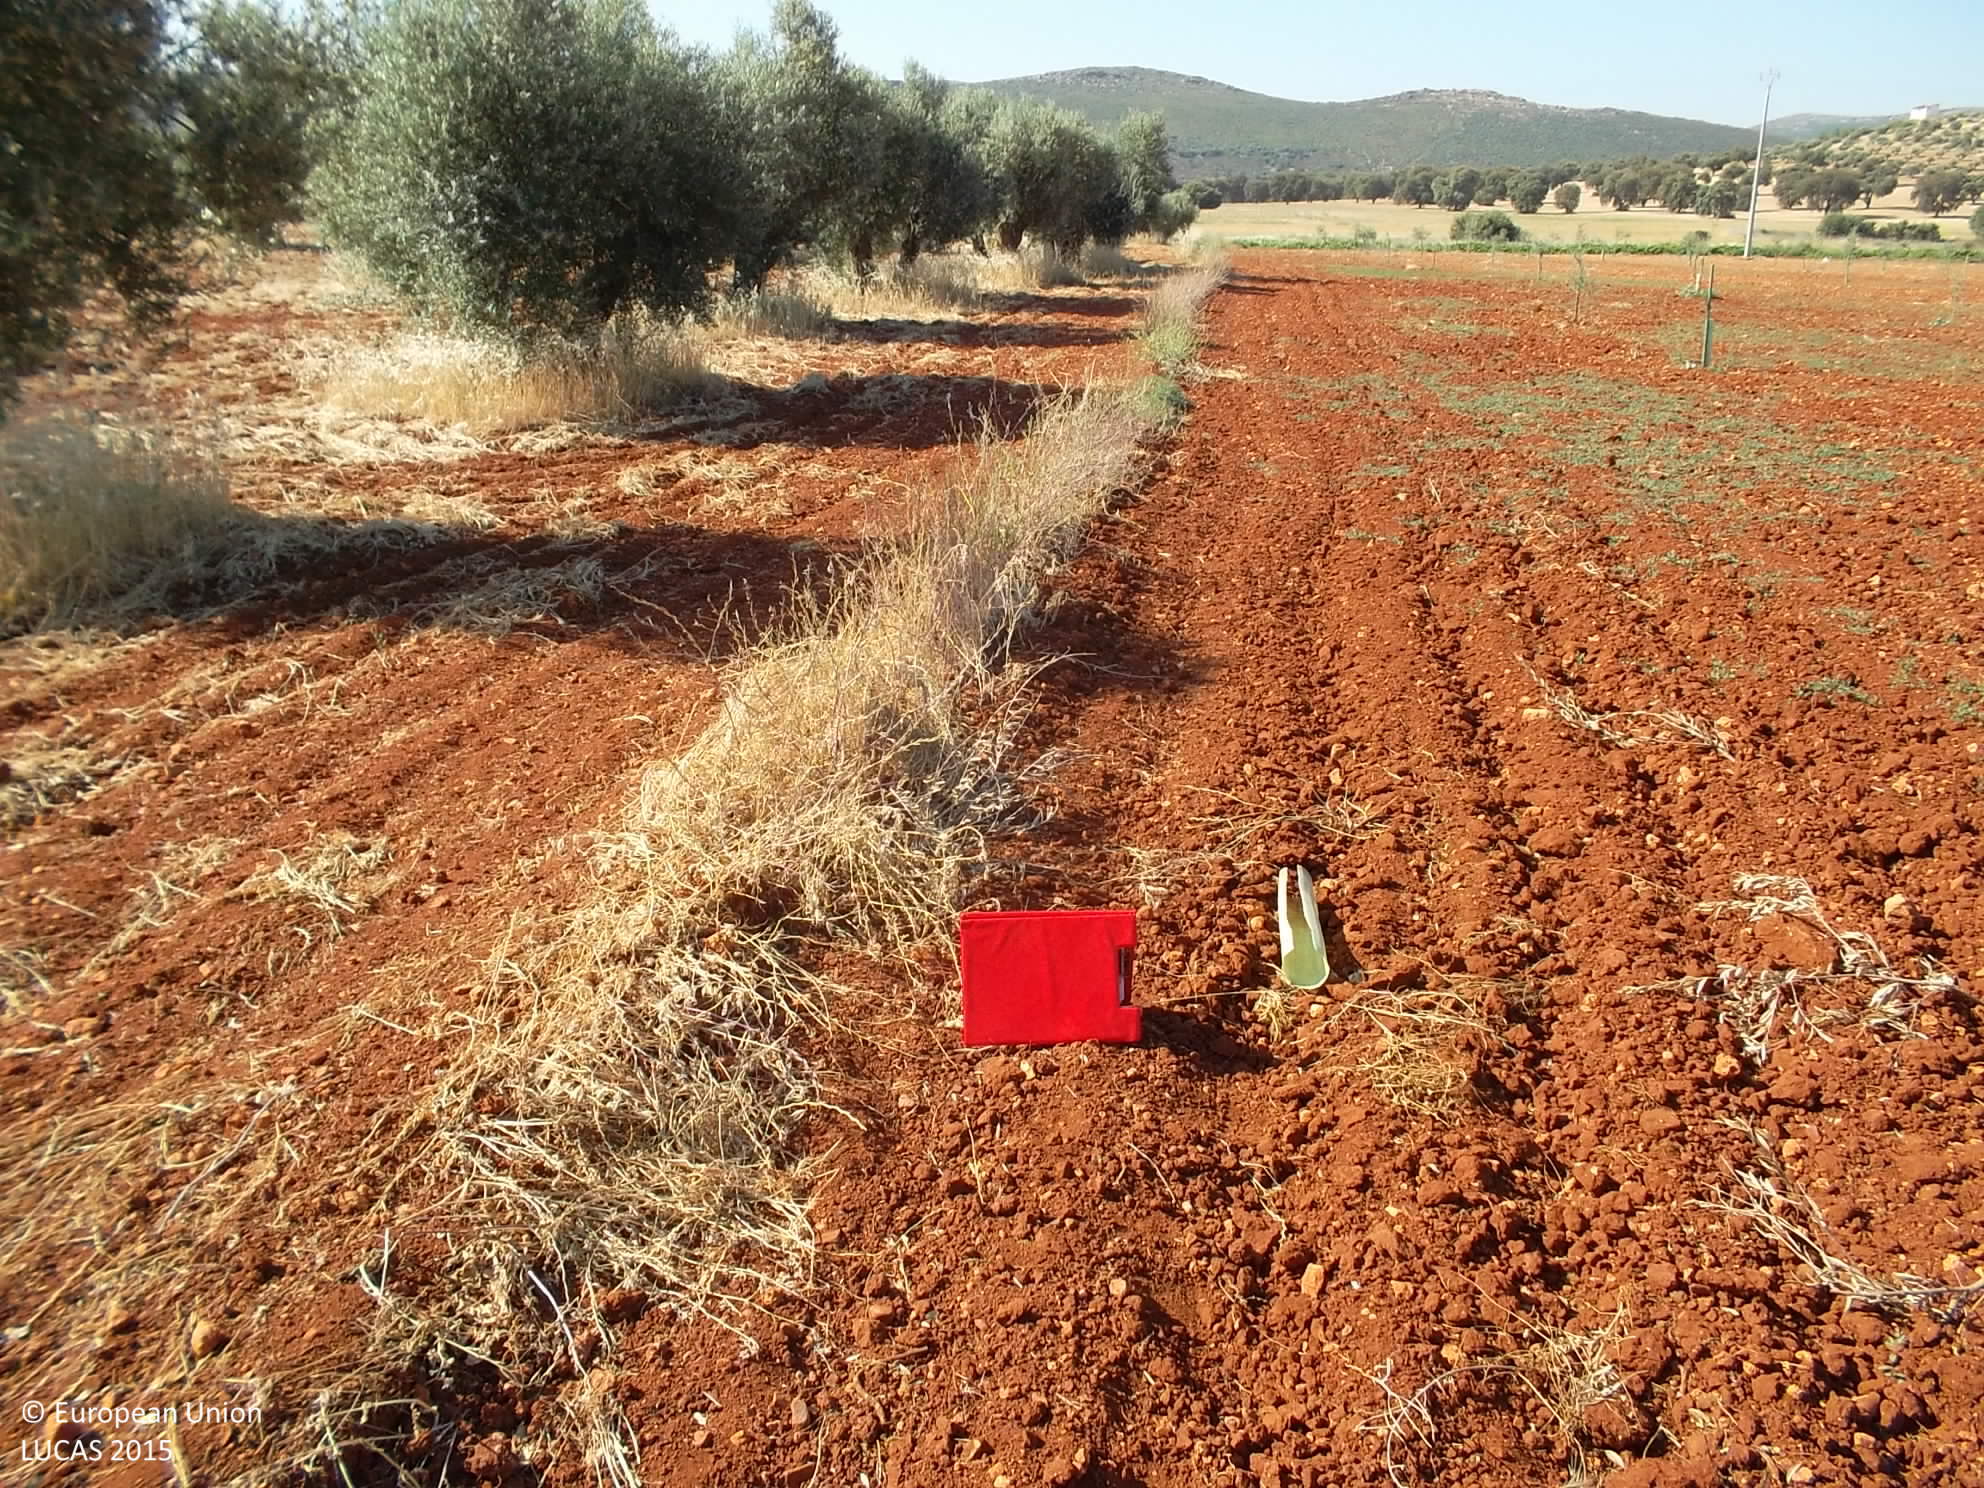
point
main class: Cropland
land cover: Olive groves
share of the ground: 10 - 25 %
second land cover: Other bare soil
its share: > 75 %
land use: Agriculture (excluding fallow land and kitchen gardens)
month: June
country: ES
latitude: 38.7416
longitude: -4.0196
